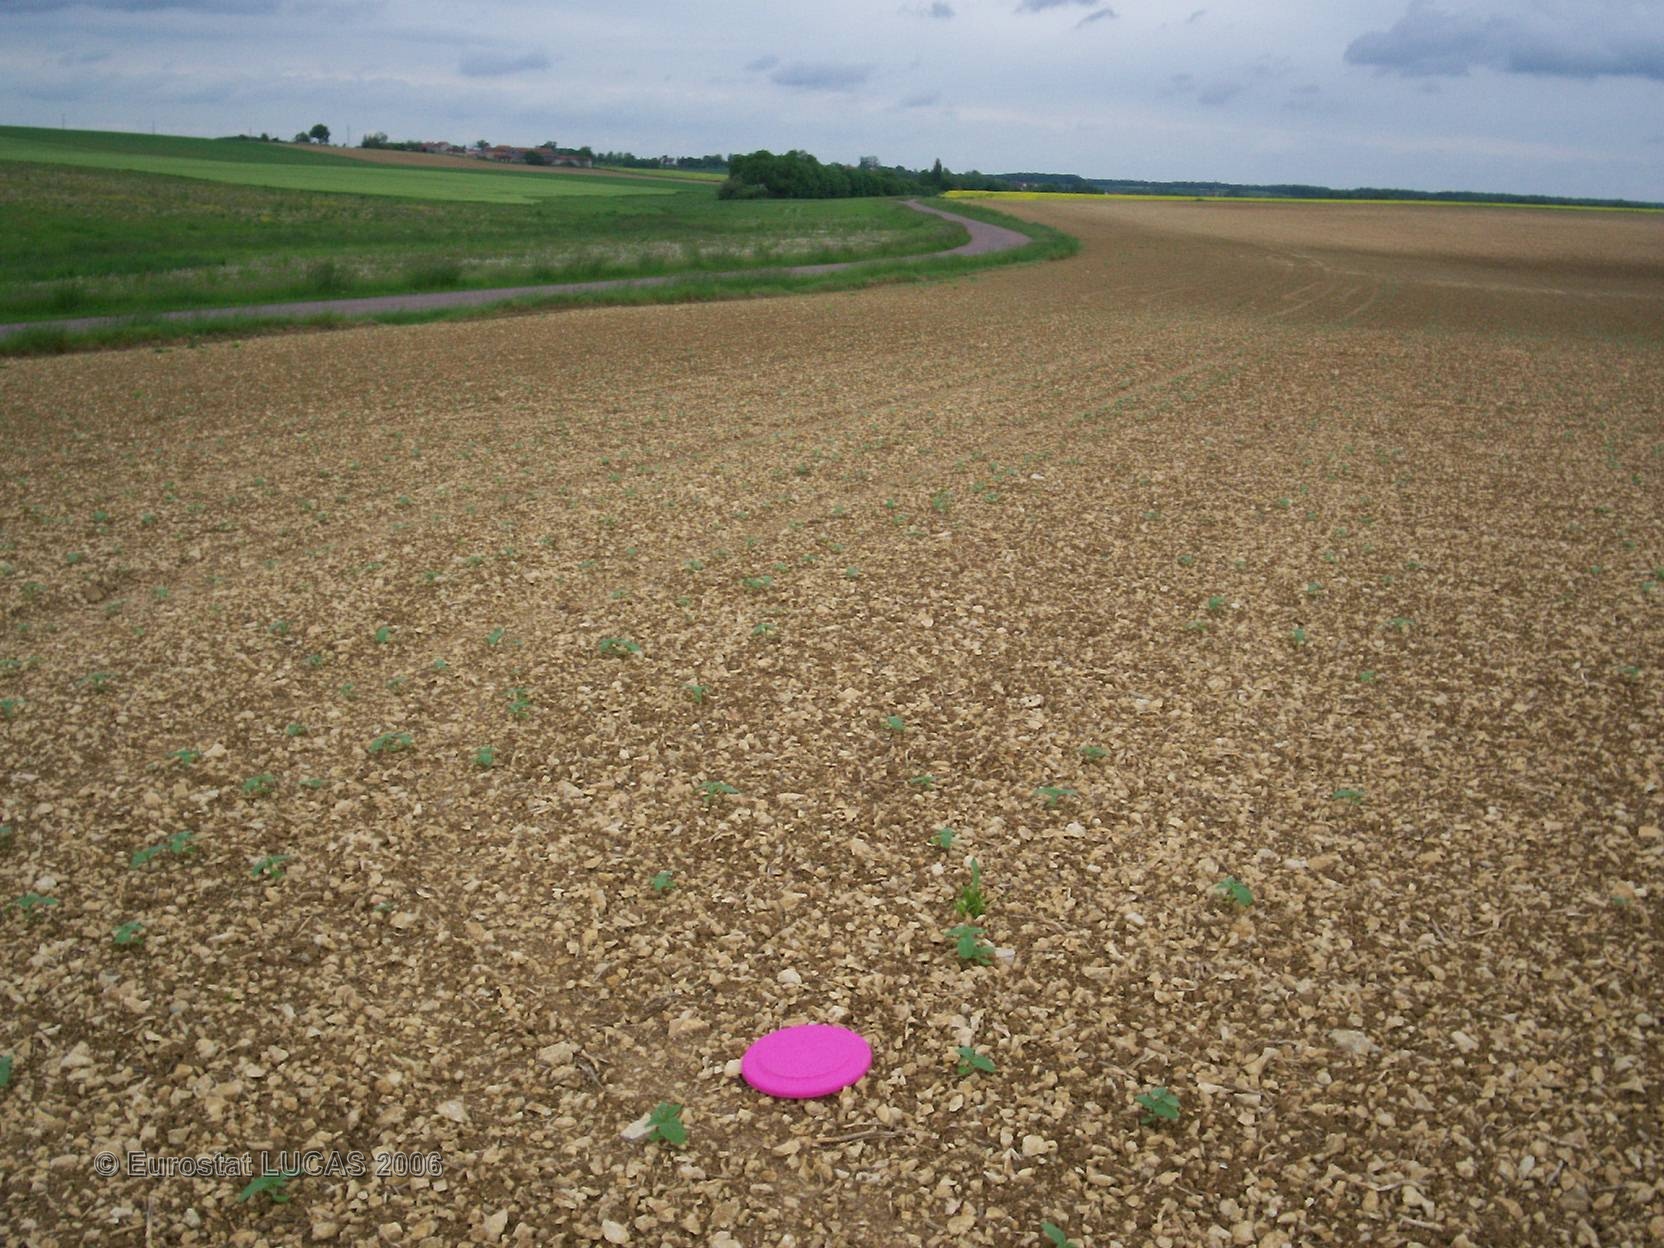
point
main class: Cropland
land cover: Sunflower
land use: Agriculture (excluding fallow land and kitchen gardens)
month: May
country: FR
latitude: 48.2109
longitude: 4.4666
